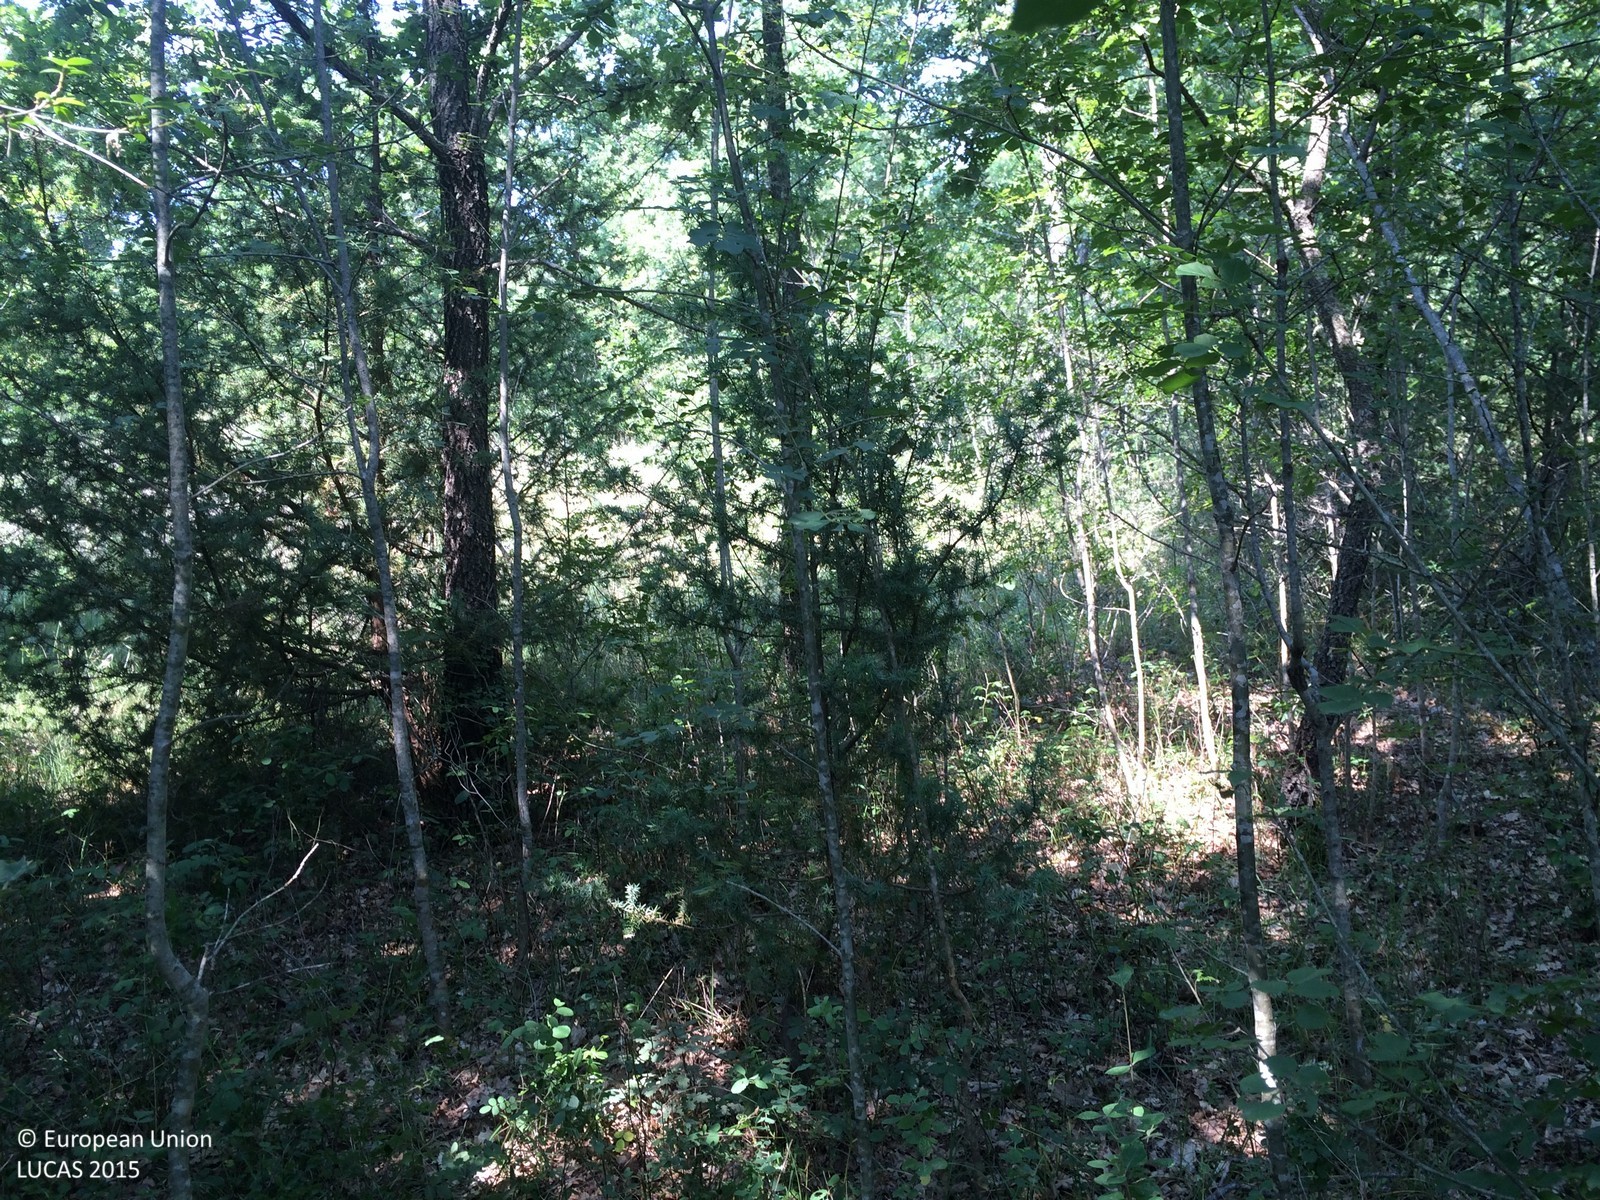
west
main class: Woodland
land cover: Broadleaved woodland
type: mesophytic deciduous forest
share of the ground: > 75 %
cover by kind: broadleaved forest trees 95 %, shrubs 5 %
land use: Semi-natural and natural areas not in use
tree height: > 5 m
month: June
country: HR
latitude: 45.0971
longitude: 13.6924
